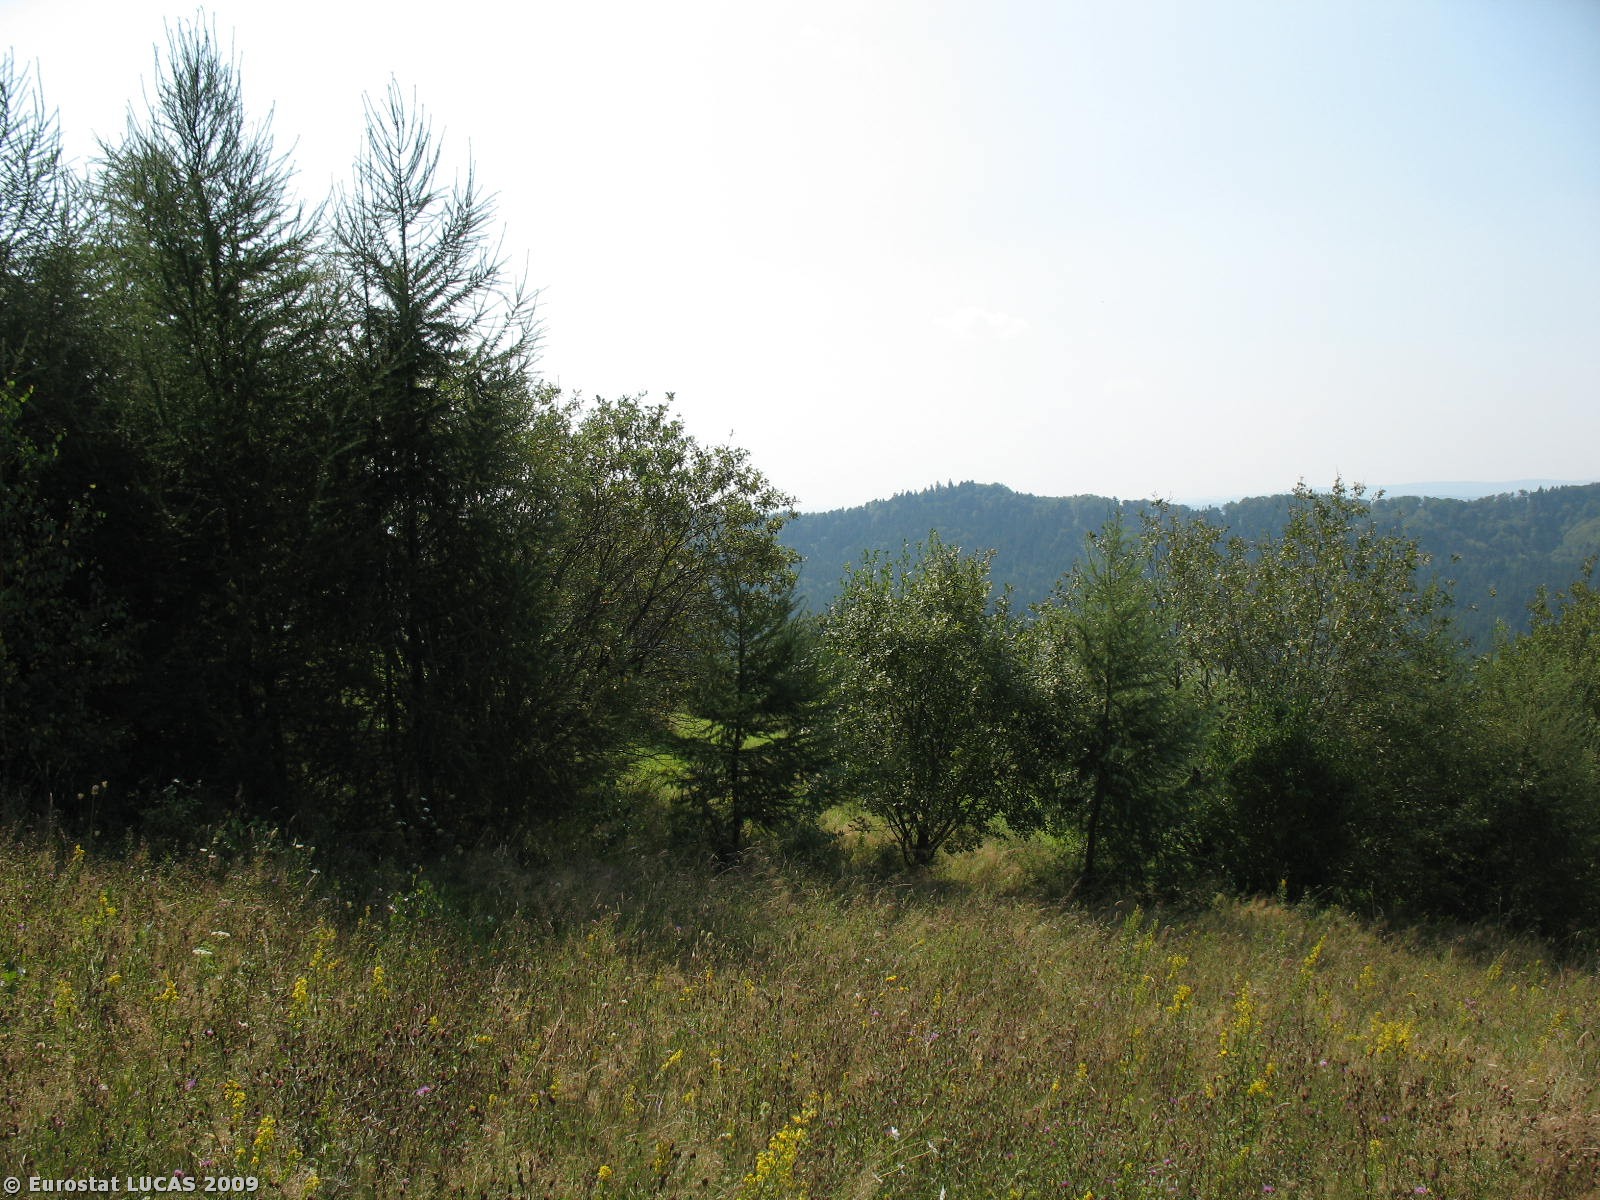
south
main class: Grassland
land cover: Spontaneously vegetated surfaces
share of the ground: > 75 %
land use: Fallow land
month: August
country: PL
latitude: 49.5936
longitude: 22.2487
